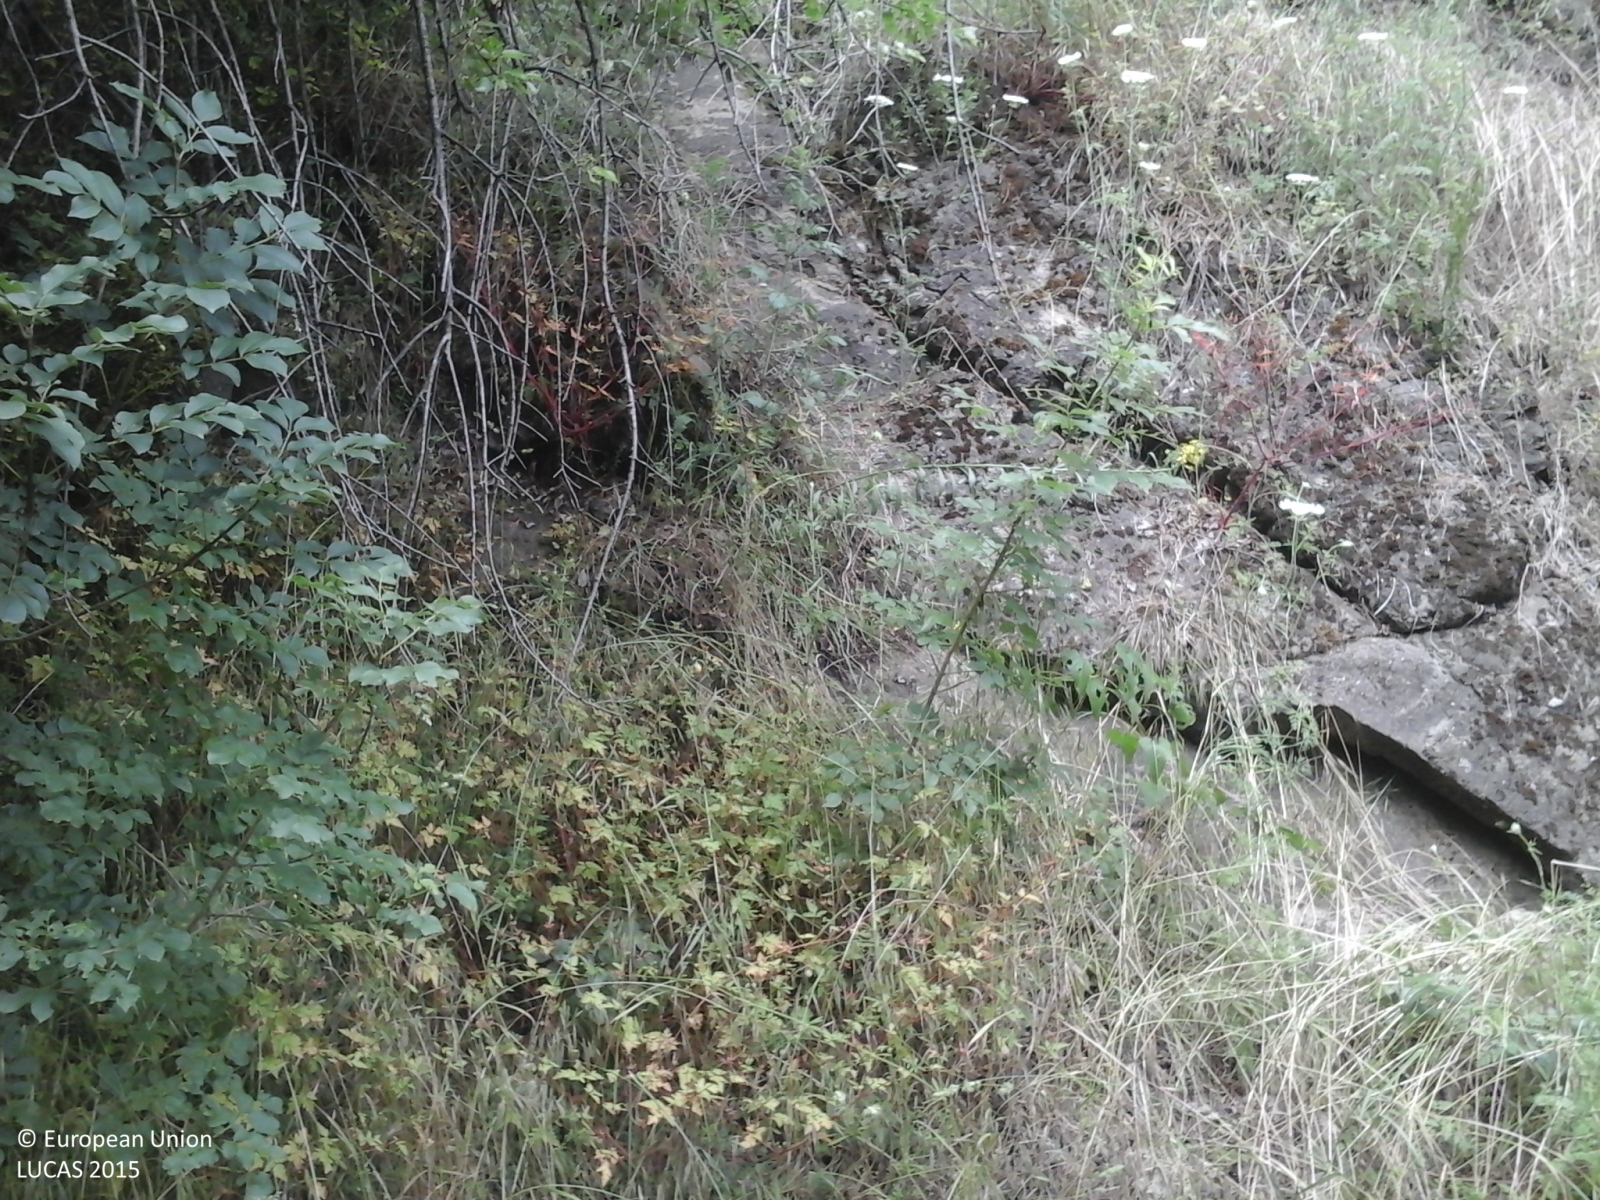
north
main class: Woodland
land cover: Broadleaved woodland
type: mire and swamp forests
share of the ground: > 75 %
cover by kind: broadleaved forest trees 100 %
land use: Forestry
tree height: > 5 m
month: May
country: IT
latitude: 45.4567
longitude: 11.5703
